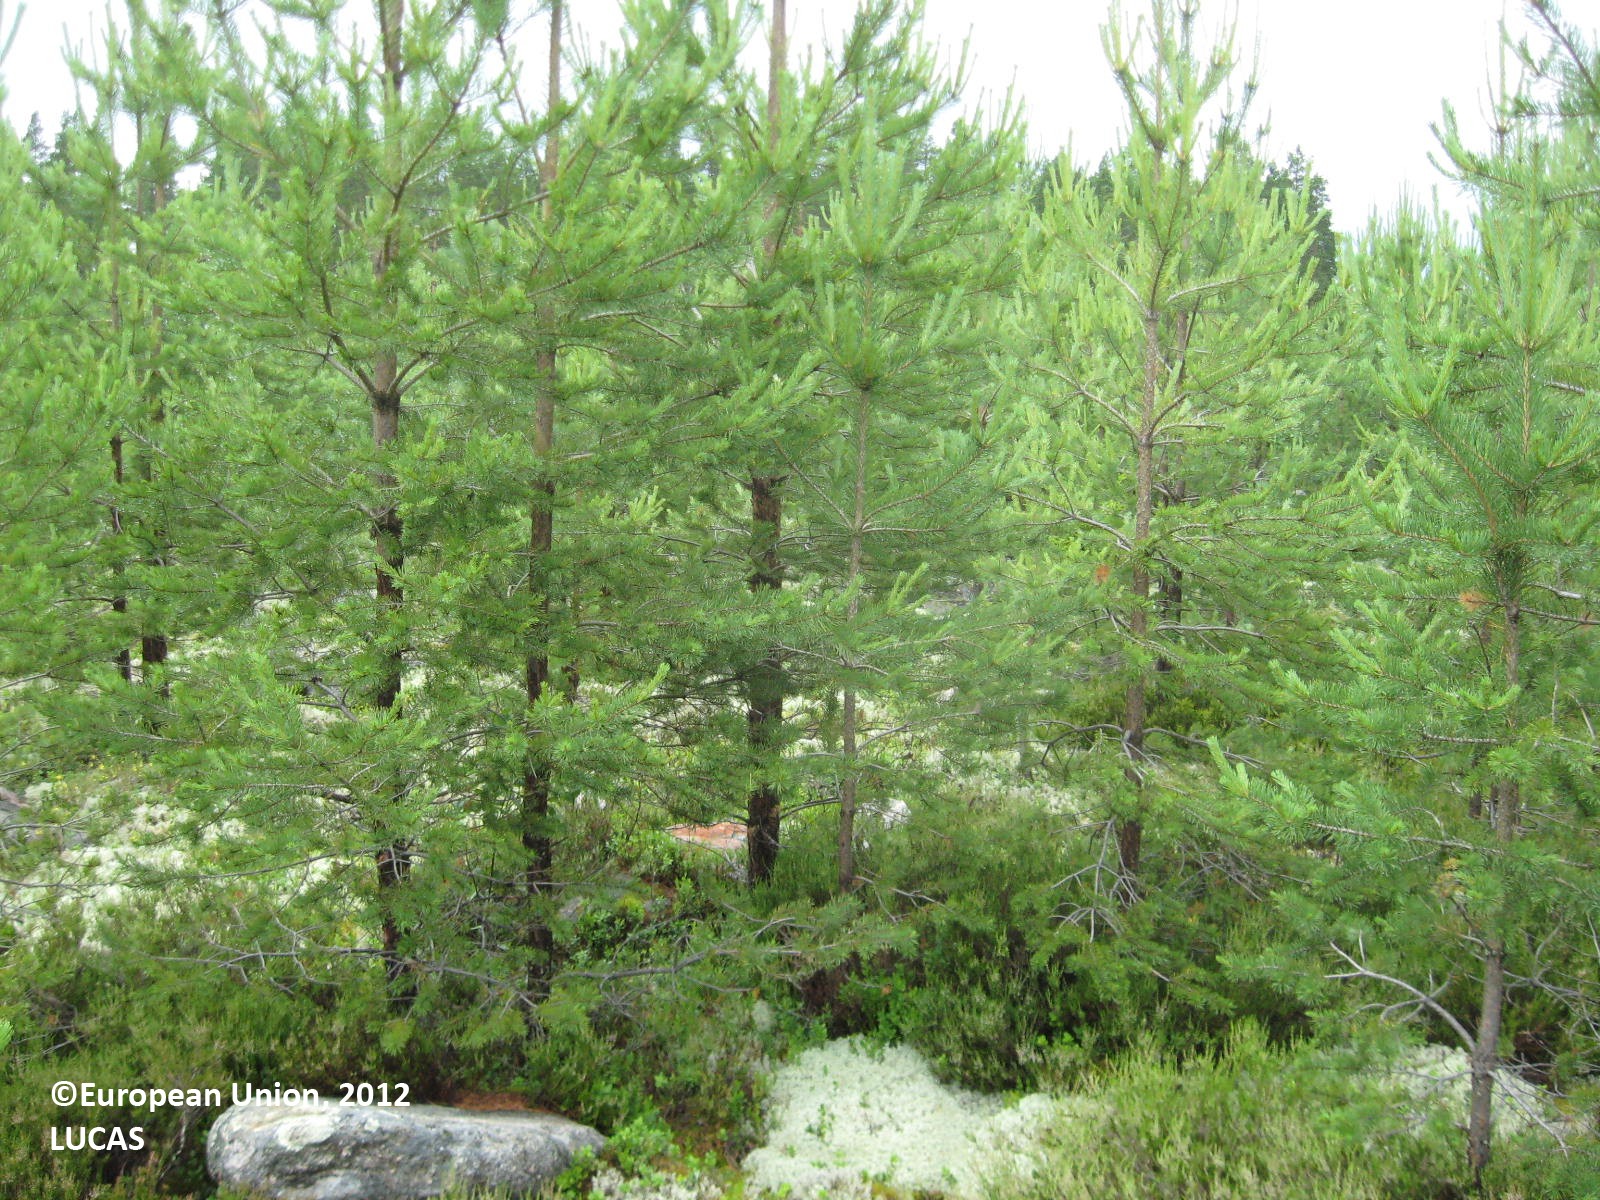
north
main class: Woodland
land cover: Pine dominated coniferous woodland
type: boreal forest
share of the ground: 50 - 75 %
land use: Forestry
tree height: < 5 m
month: July
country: FI
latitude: 62.4566
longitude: 22.4812
